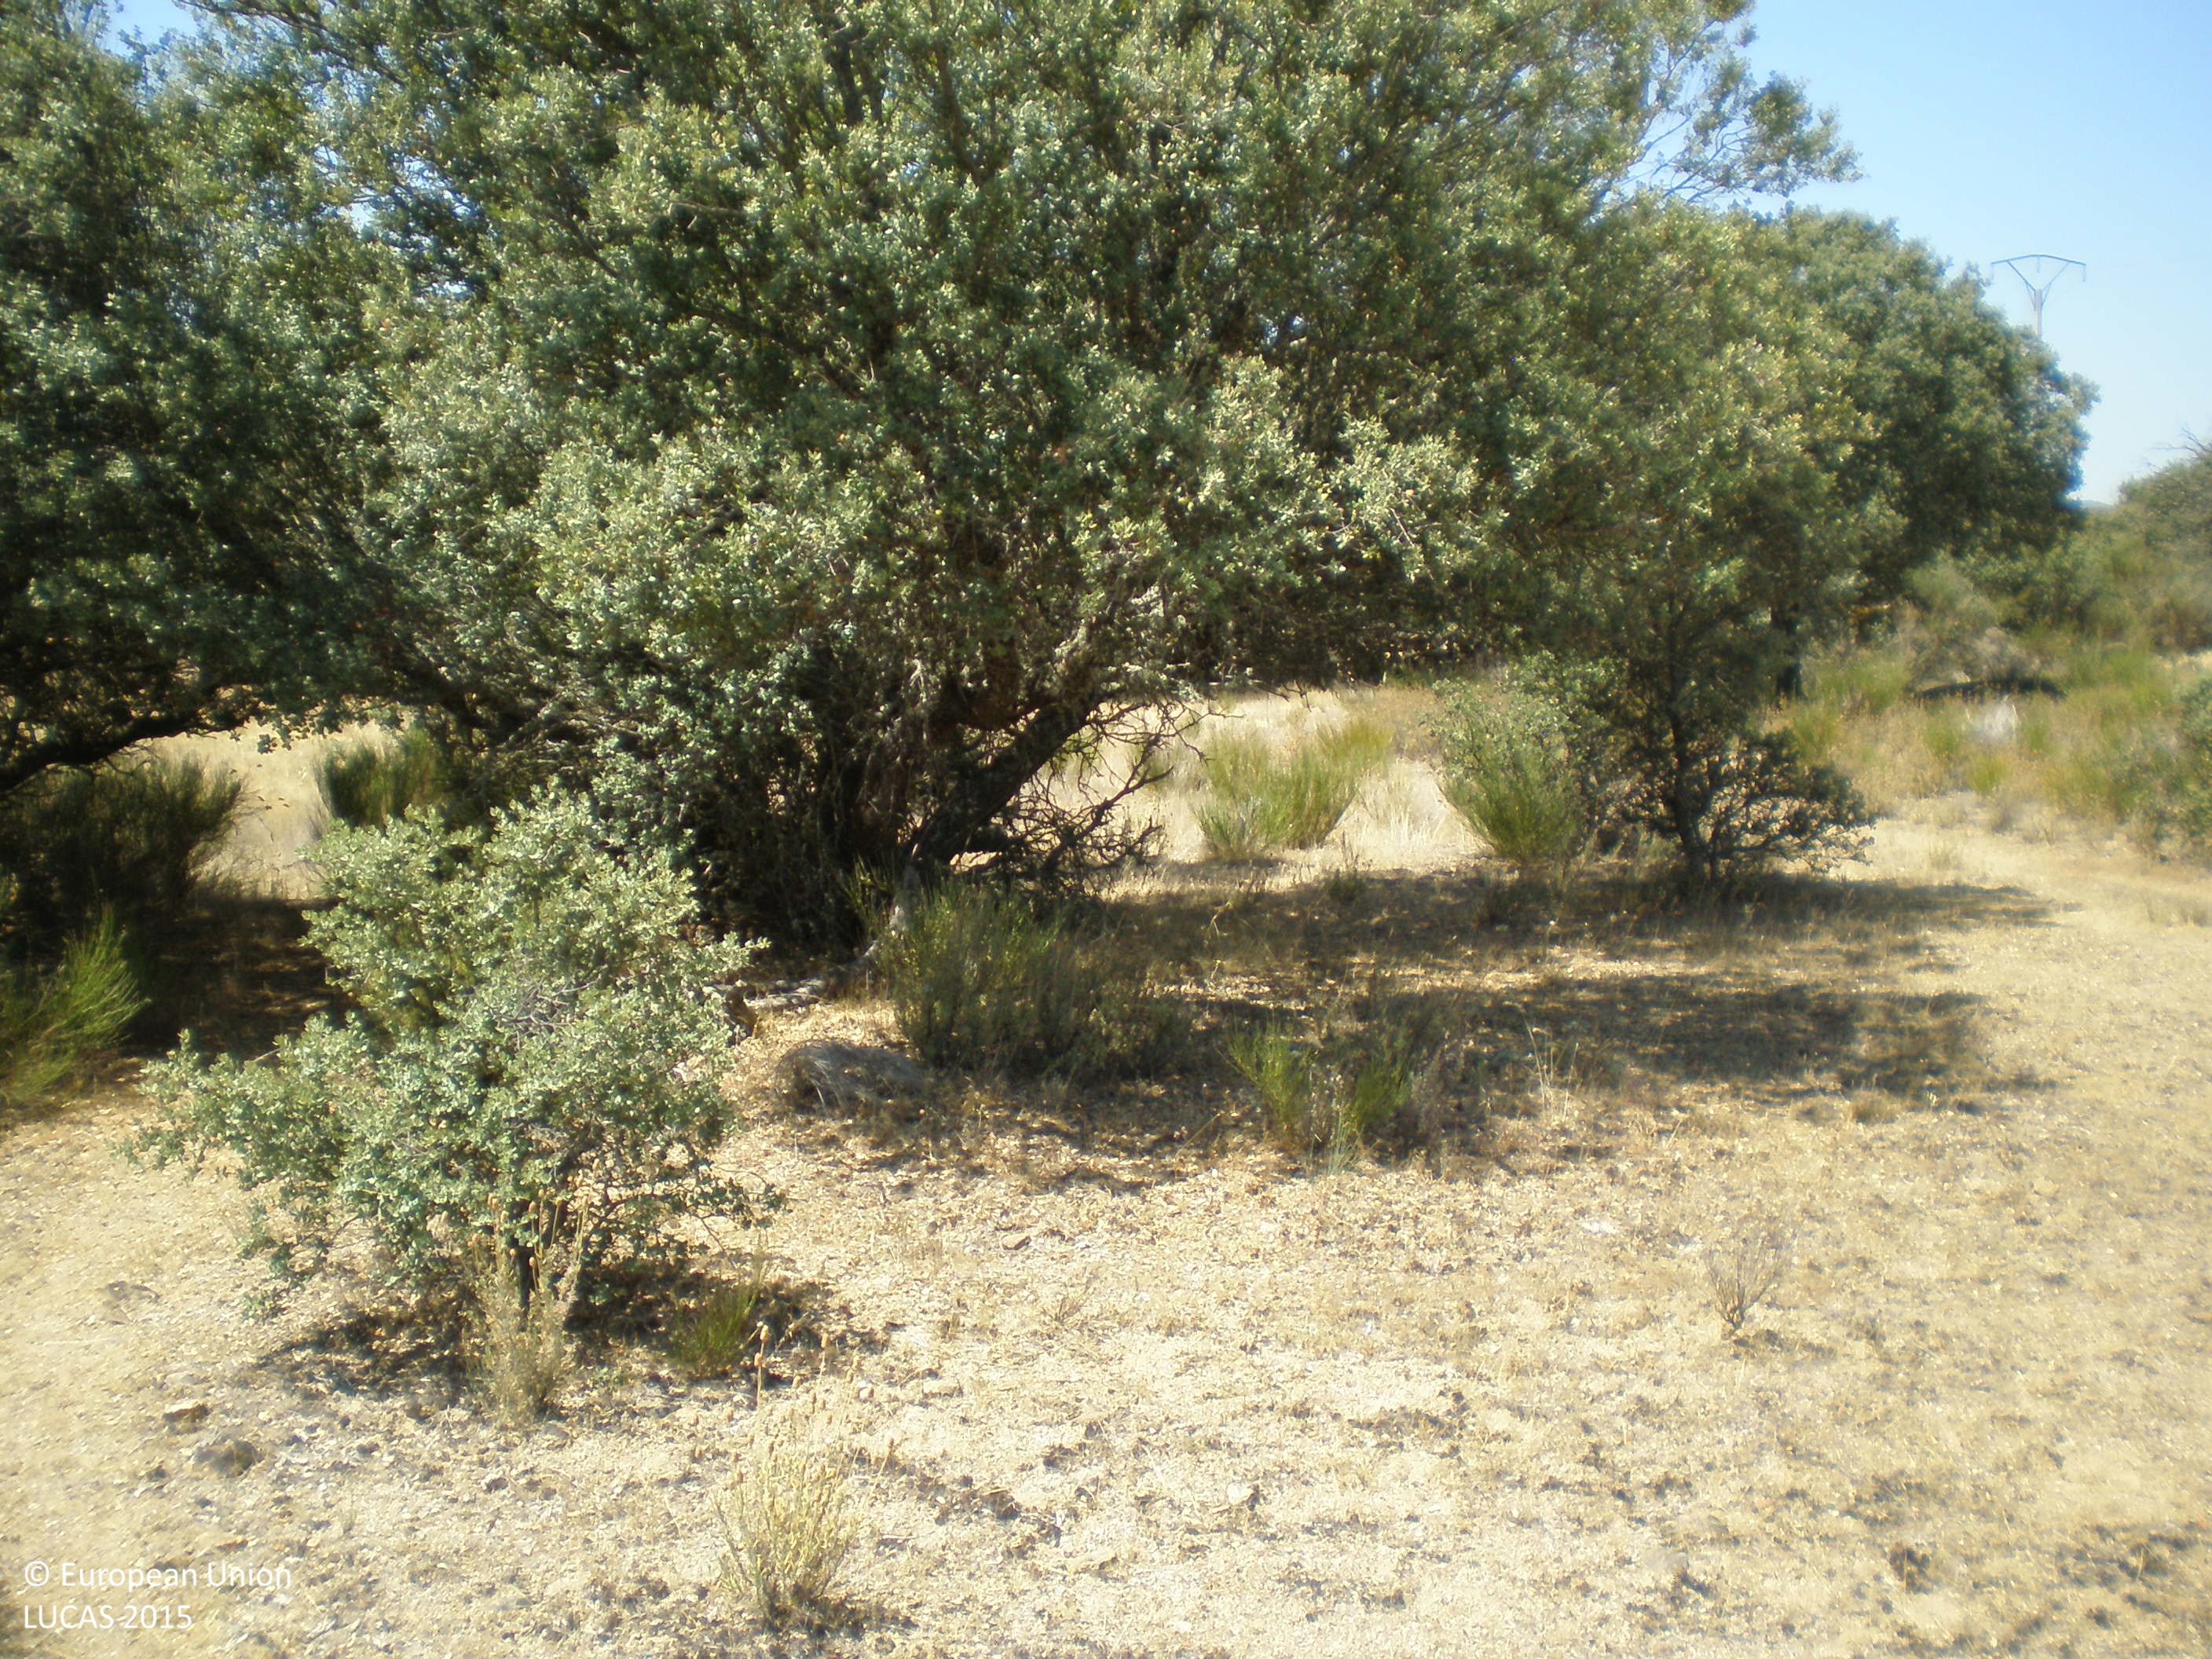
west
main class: Woodland
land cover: Broadleaved woodland
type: broadleaved evergreen forest
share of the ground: 25 - 50 %
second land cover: Grassland without tree/shrub cover
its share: 50 - 75 %
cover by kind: herbaceous plants 70 %, broadleaved forest trees 30 %
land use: Forestry
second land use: Agriculture (excluding fallow land and kitchen gardens)
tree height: > 5 m
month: July
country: ES
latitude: 40.4211
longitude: -5.5179
